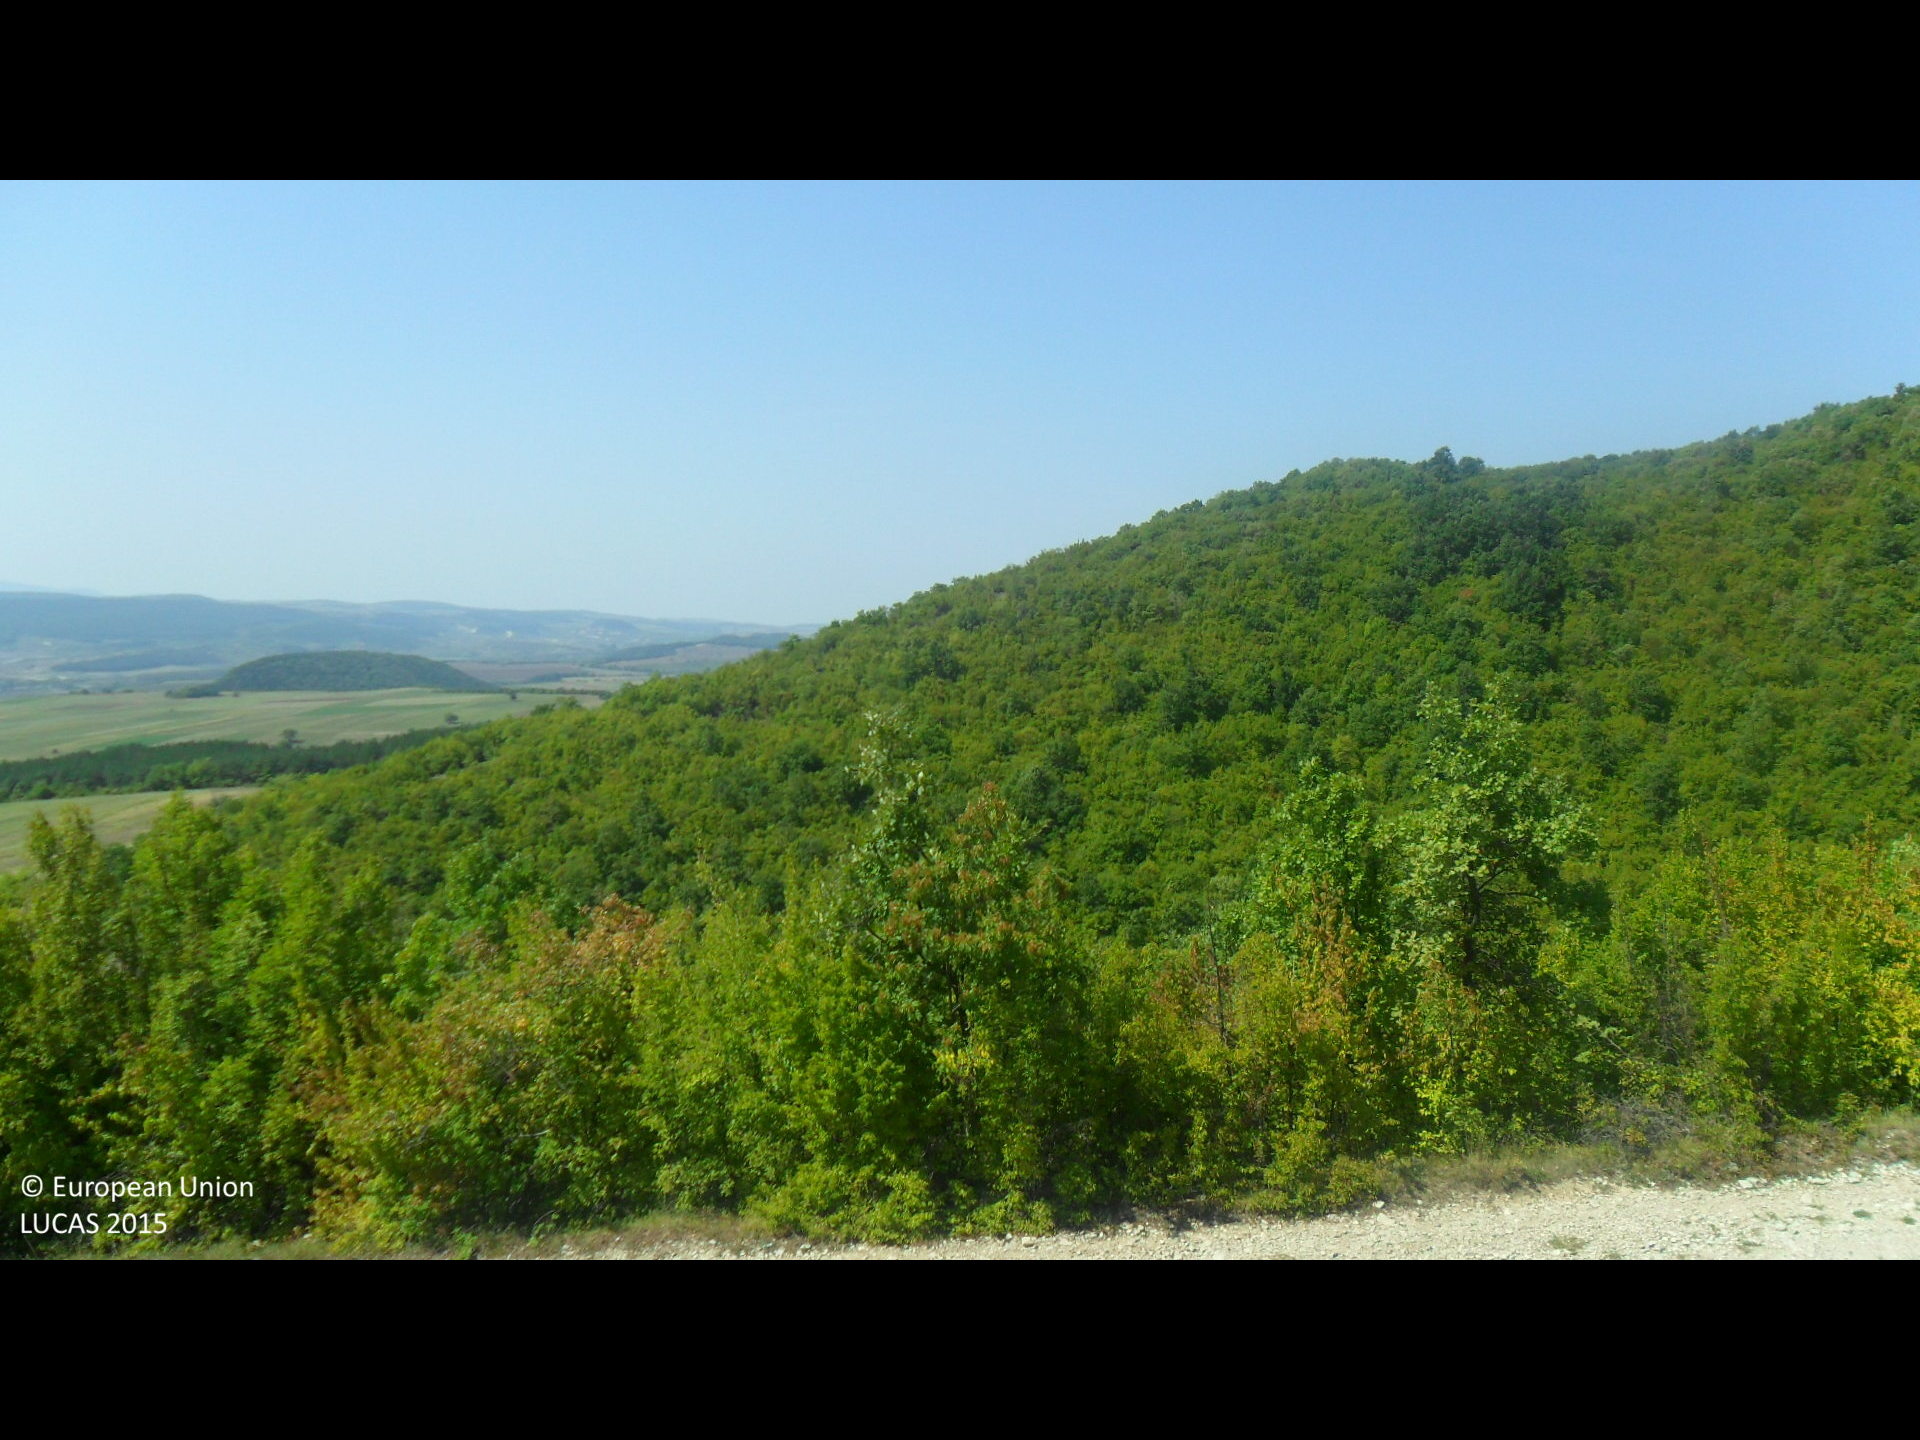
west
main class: Woodland
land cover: Broadleaved woodland
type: thermophilous deciduous forest
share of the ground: > 75 %
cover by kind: broadleaved forest trees 95 %, unconsolidated bare surface 5 %
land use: Forestry
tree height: > 5 m
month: September
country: BG
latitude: 43.1465
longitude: 26.6168
